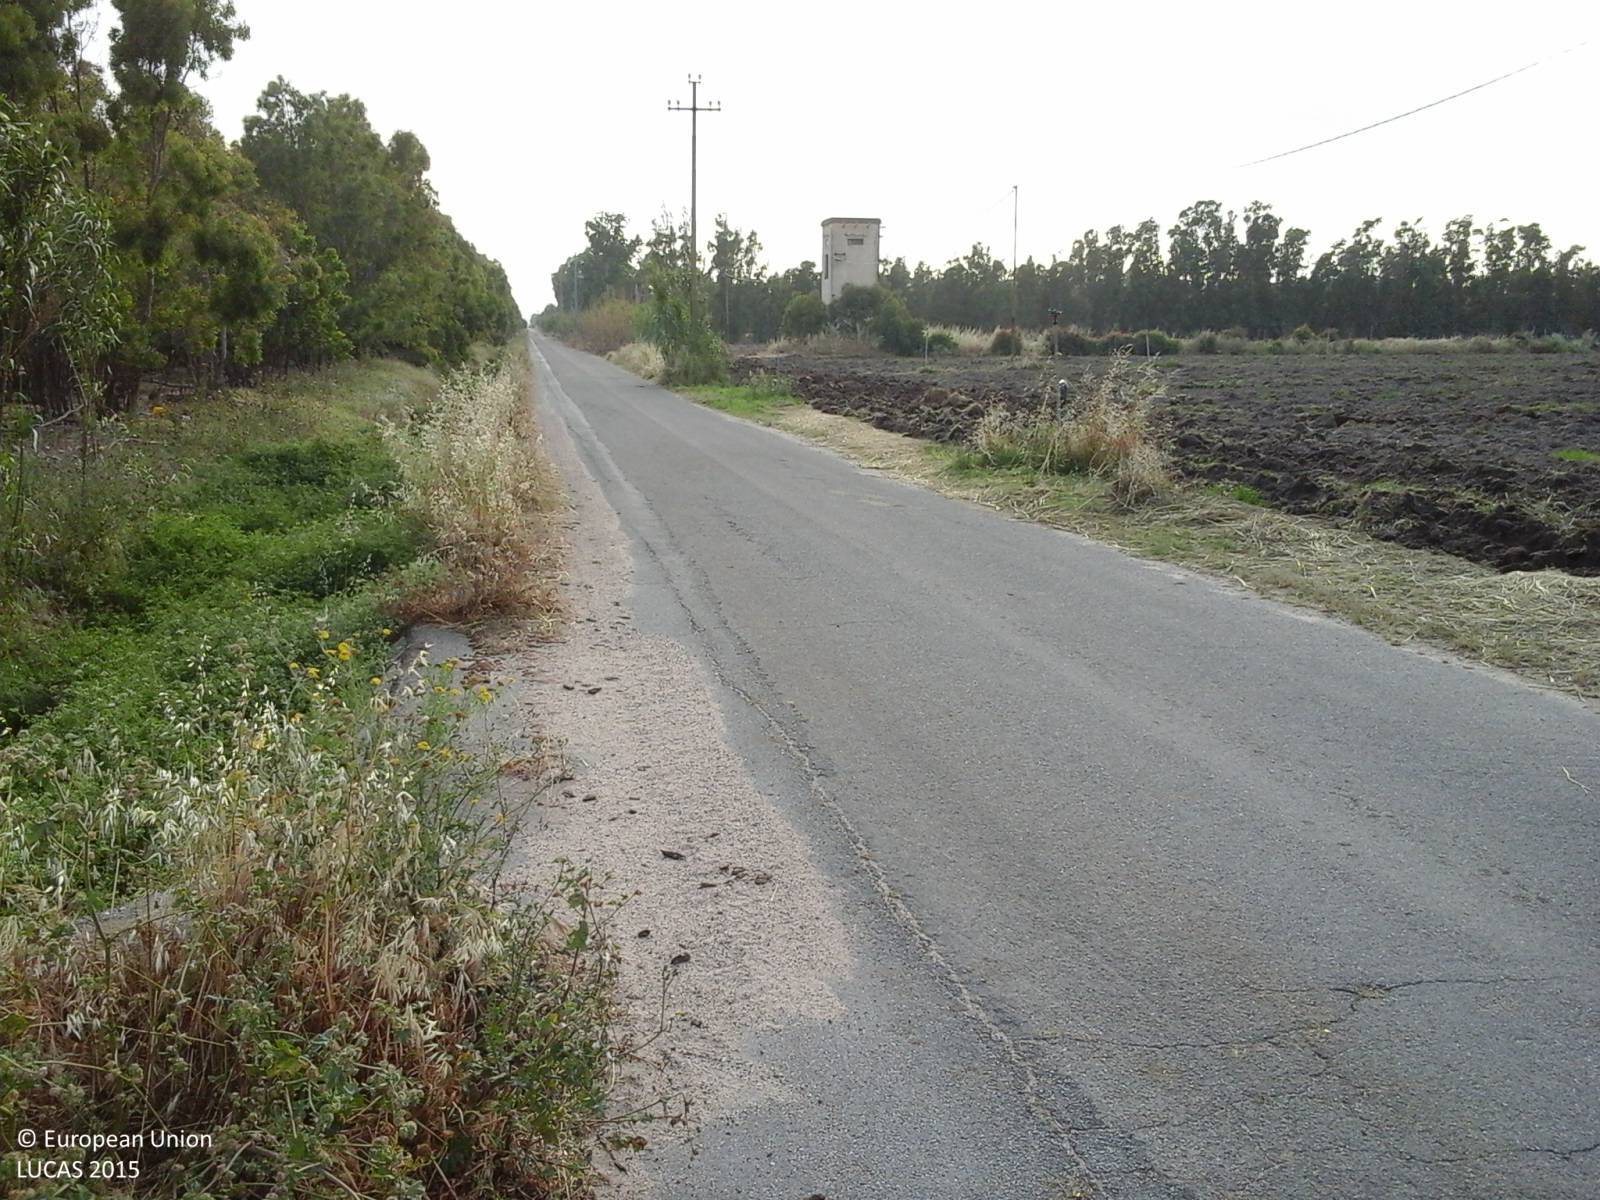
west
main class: Cropland
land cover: Clovers
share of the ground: > 75 %
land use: Agriculture (excluding fallow land and kitchen gardens)
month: May
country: IT
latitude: 39.7133
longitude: 8.5502
